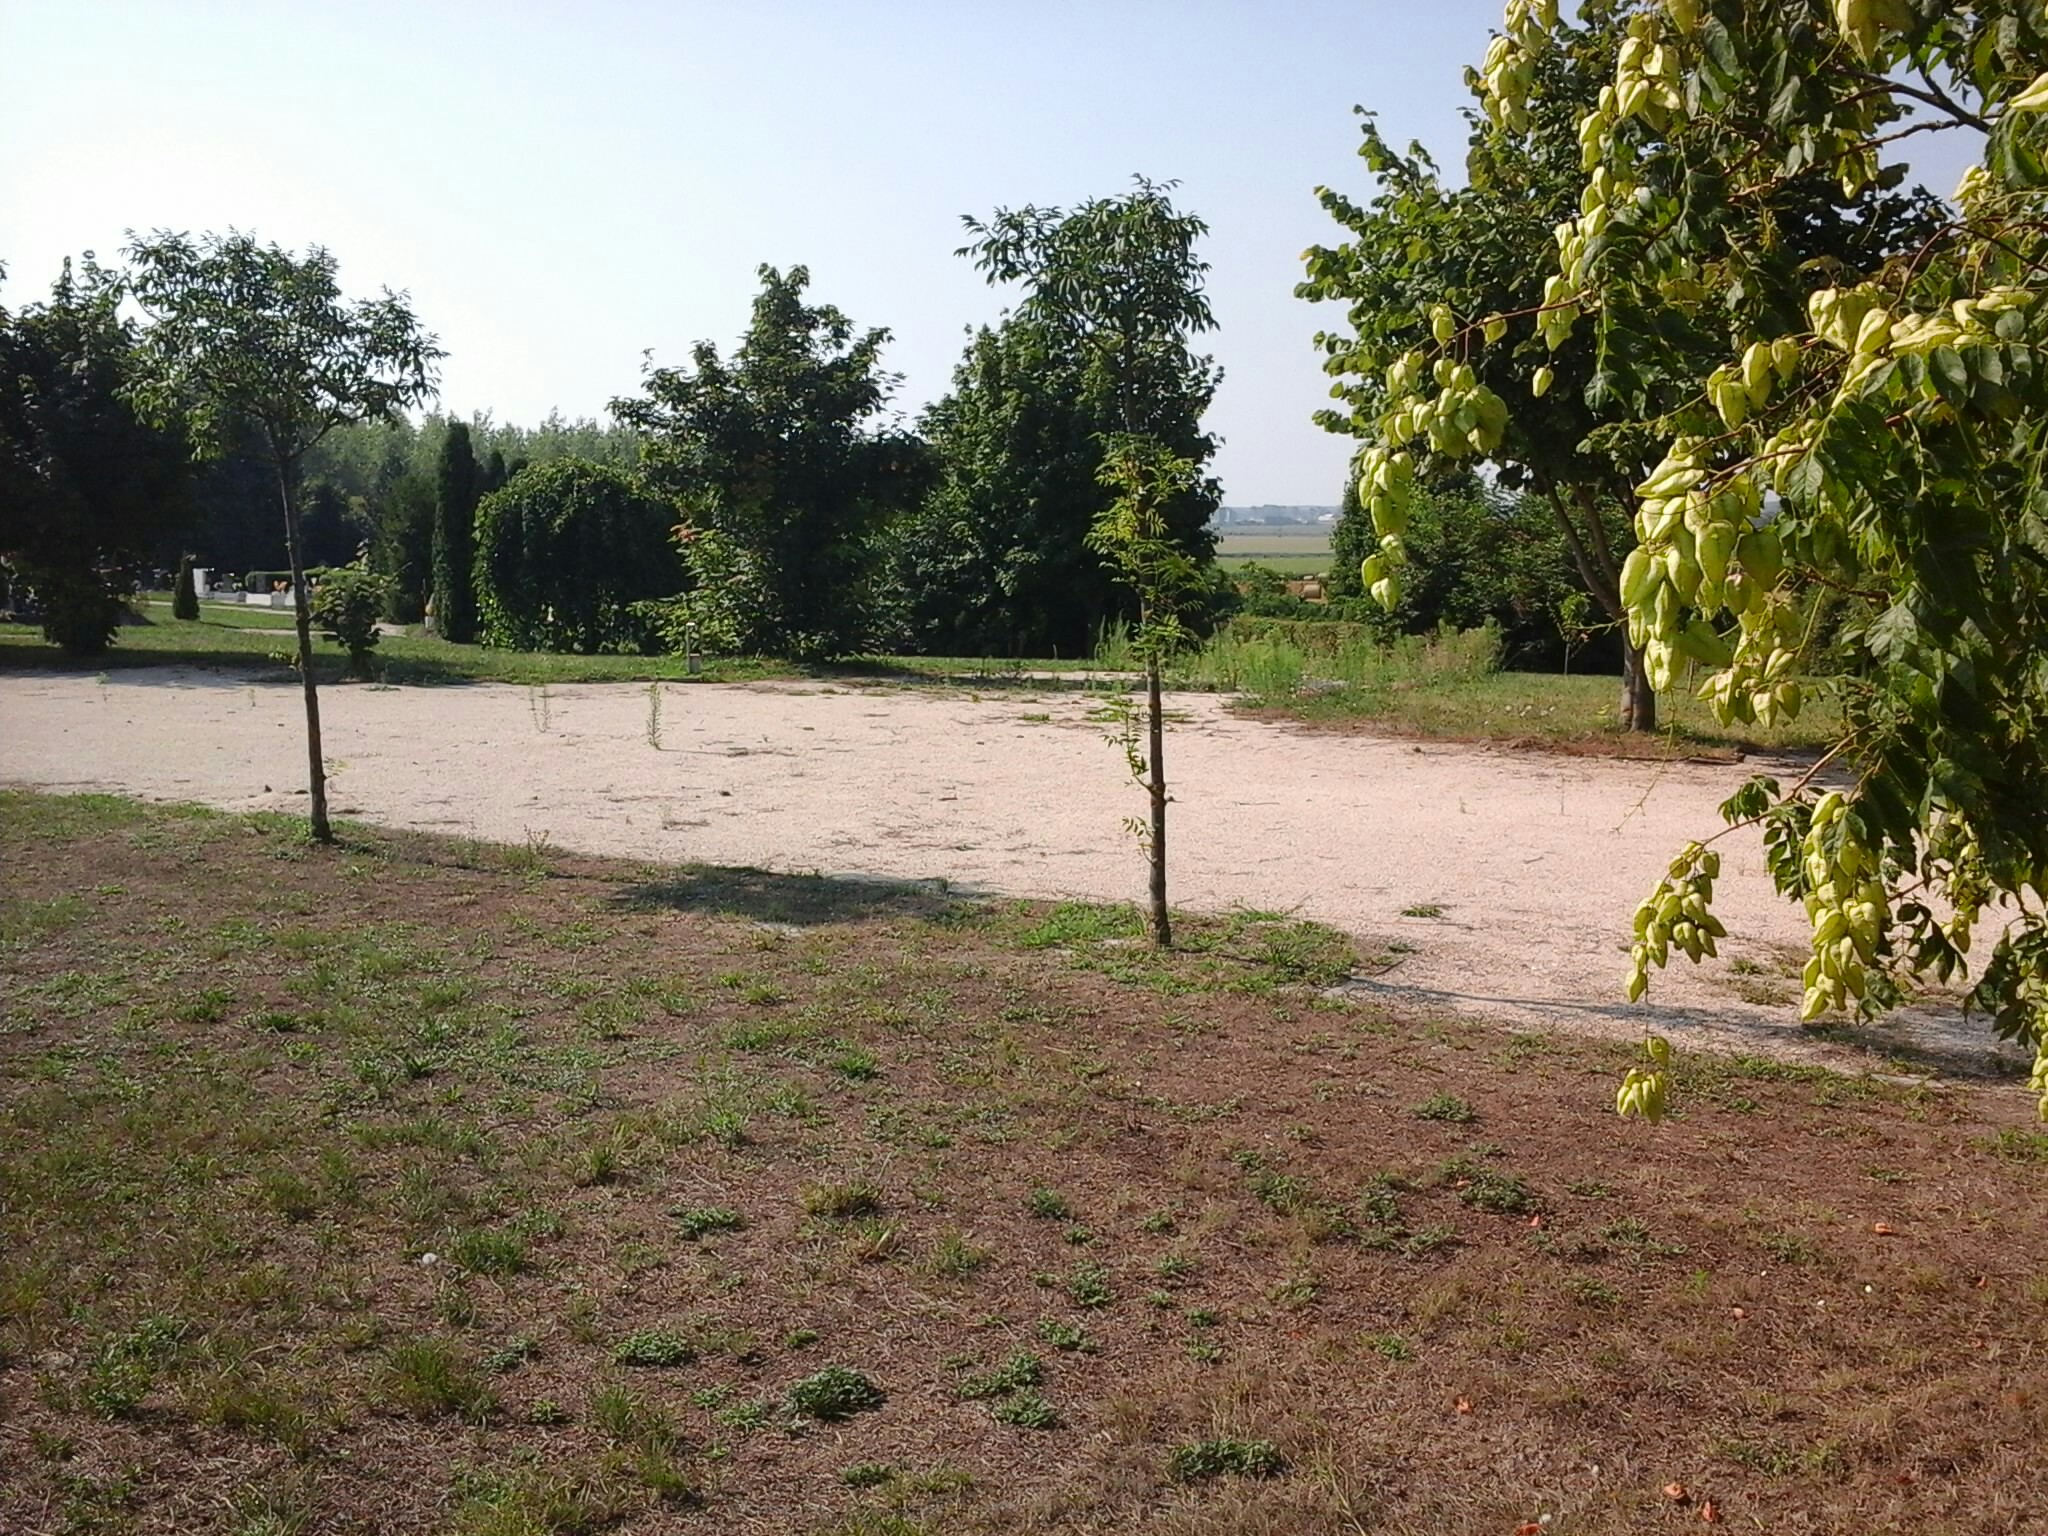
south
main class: Grassland
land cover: Grassland without tree/shrub cover
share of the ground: > 75 %
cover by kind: herbaceous plants 95 %, shrubs 5 %
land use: Community services
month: August
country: HU
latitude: 47.6462
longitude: 17.9583
